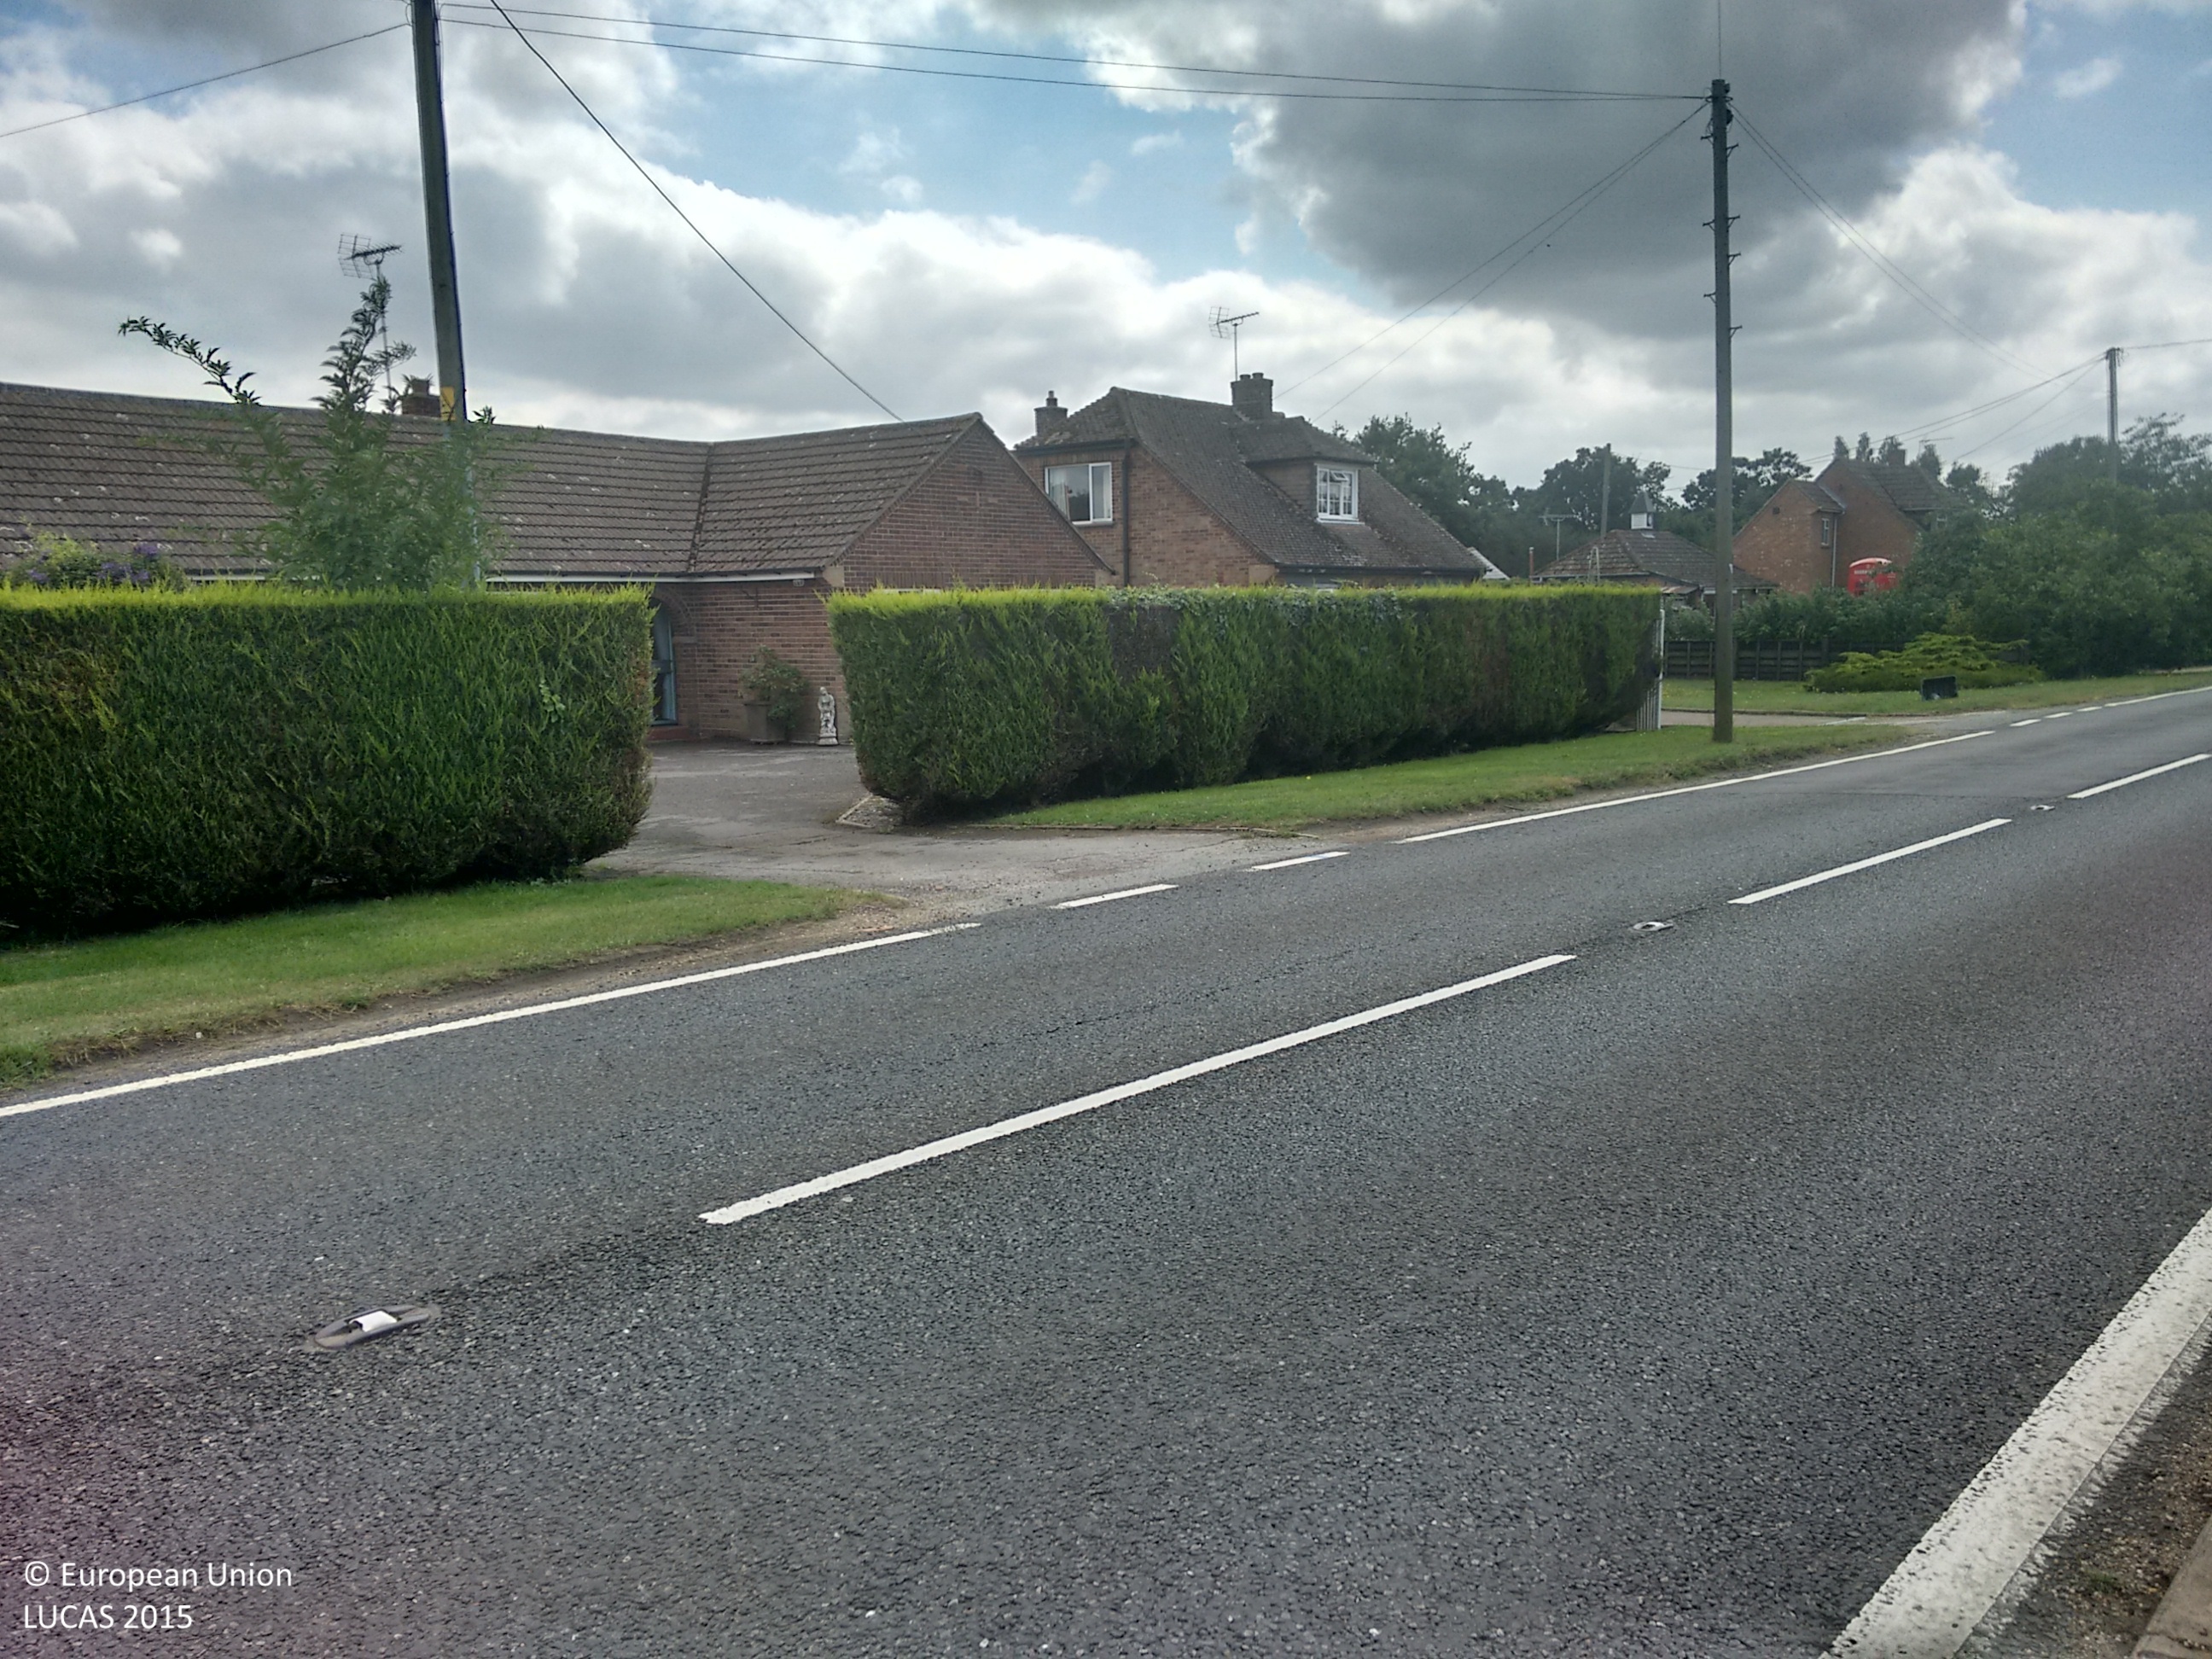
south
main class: Grassland
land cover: Grassland without tree/shrub cover
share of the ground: > 75 %
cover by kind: herbaceous plants 100 %
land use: Agriculture (excluding fallow land and kitchen gardens)
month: August
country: GB
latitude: 51.9246
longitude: 0.9754
